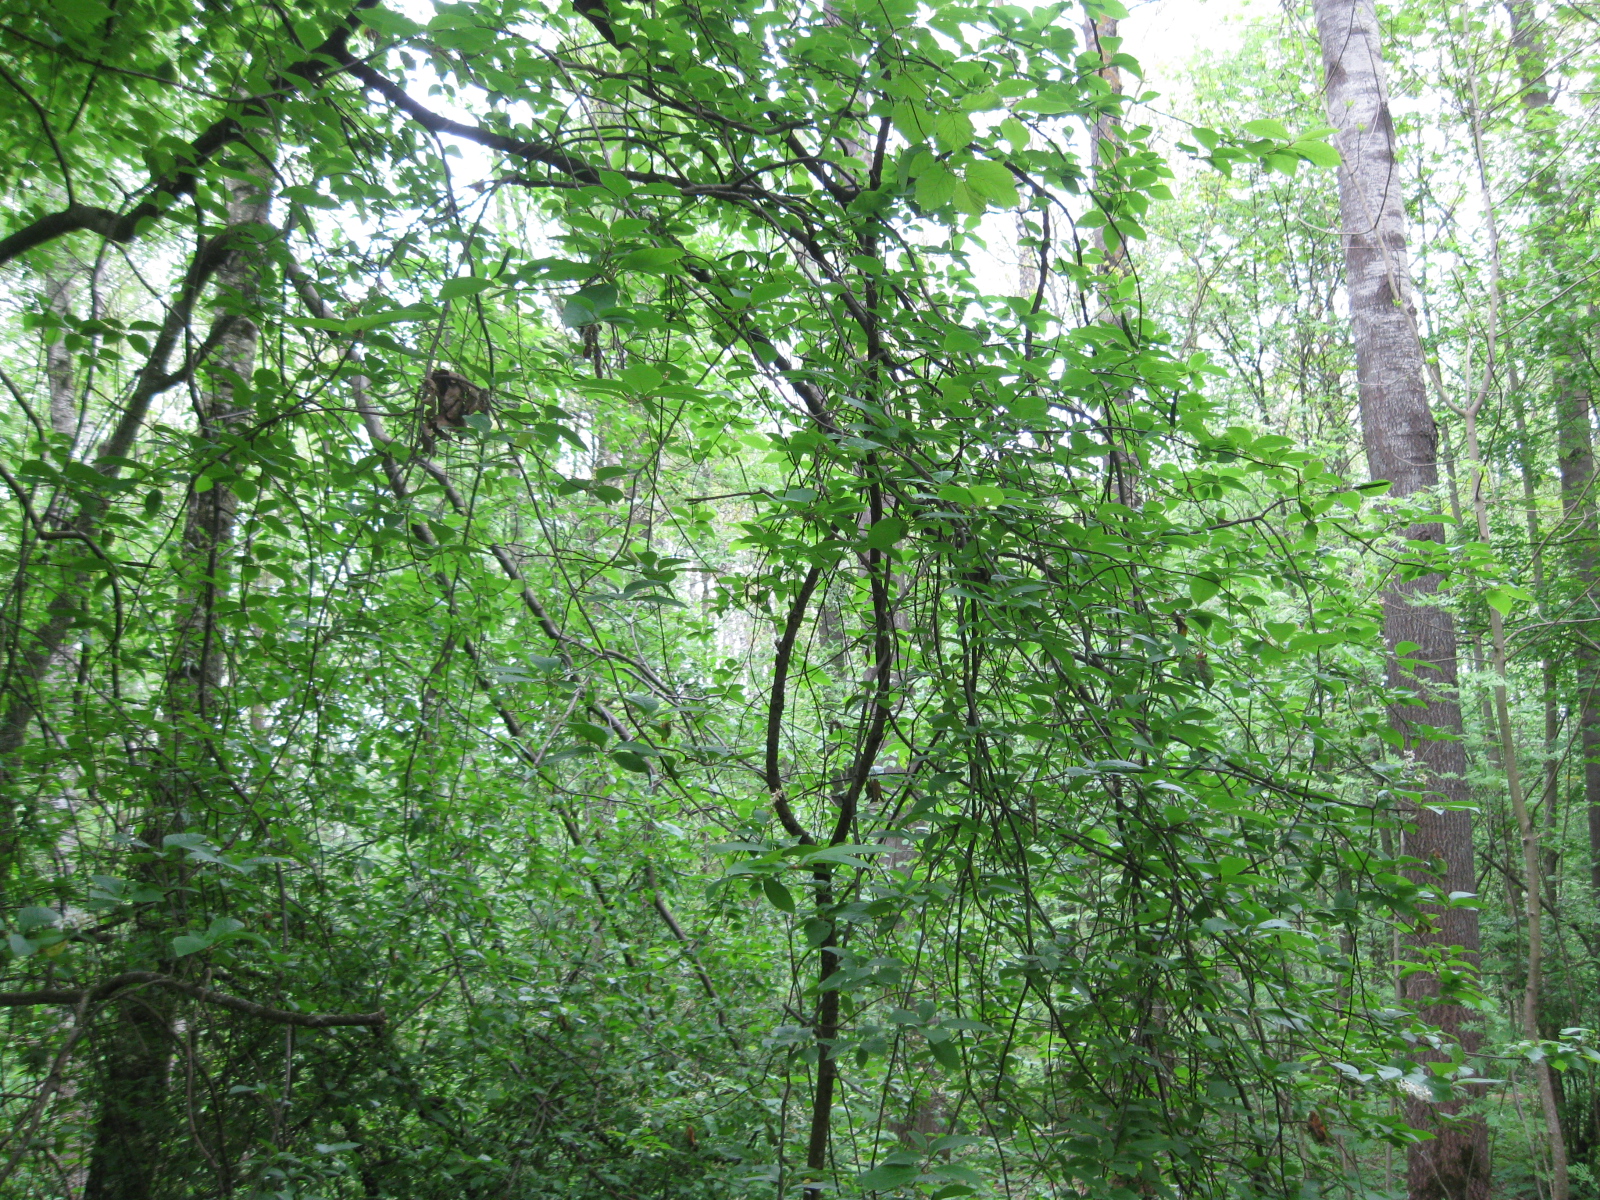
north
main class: Woodland
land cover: Broadleaved woodland
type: non-riverine alder, birch or aspen forest
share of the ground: > 75 %
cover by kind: broadleaved forest trees 90 %, herbaceous plants 10 %
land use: Forestry
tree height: > 5 m
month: May
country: LT
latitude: 55.9728
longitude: 24.4051
